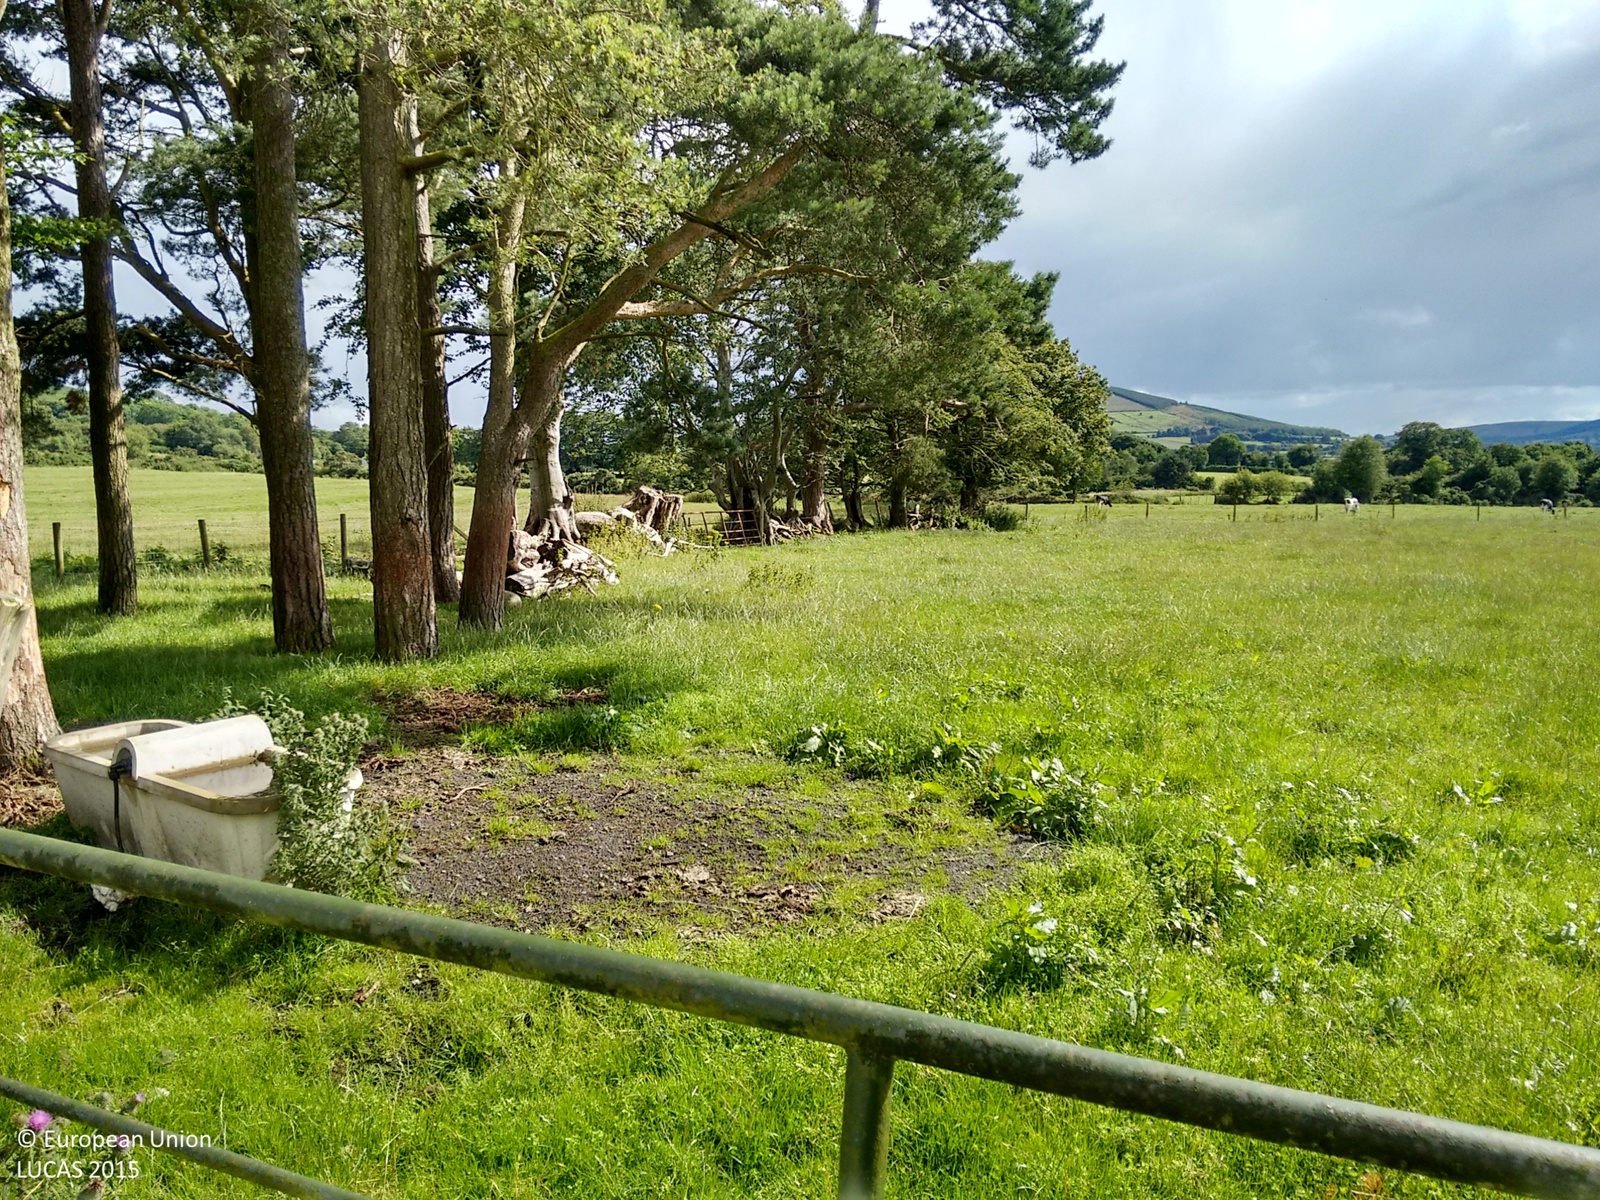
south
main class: Grassland
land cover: Grassland without tree/shrub cover
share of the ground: > 75 %
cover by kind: herbaceous plants 100 %
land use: Agriculture (excluding fallow land and kitchen gardens)
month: July
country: IE
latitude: 52.8284
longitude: -6.4979
